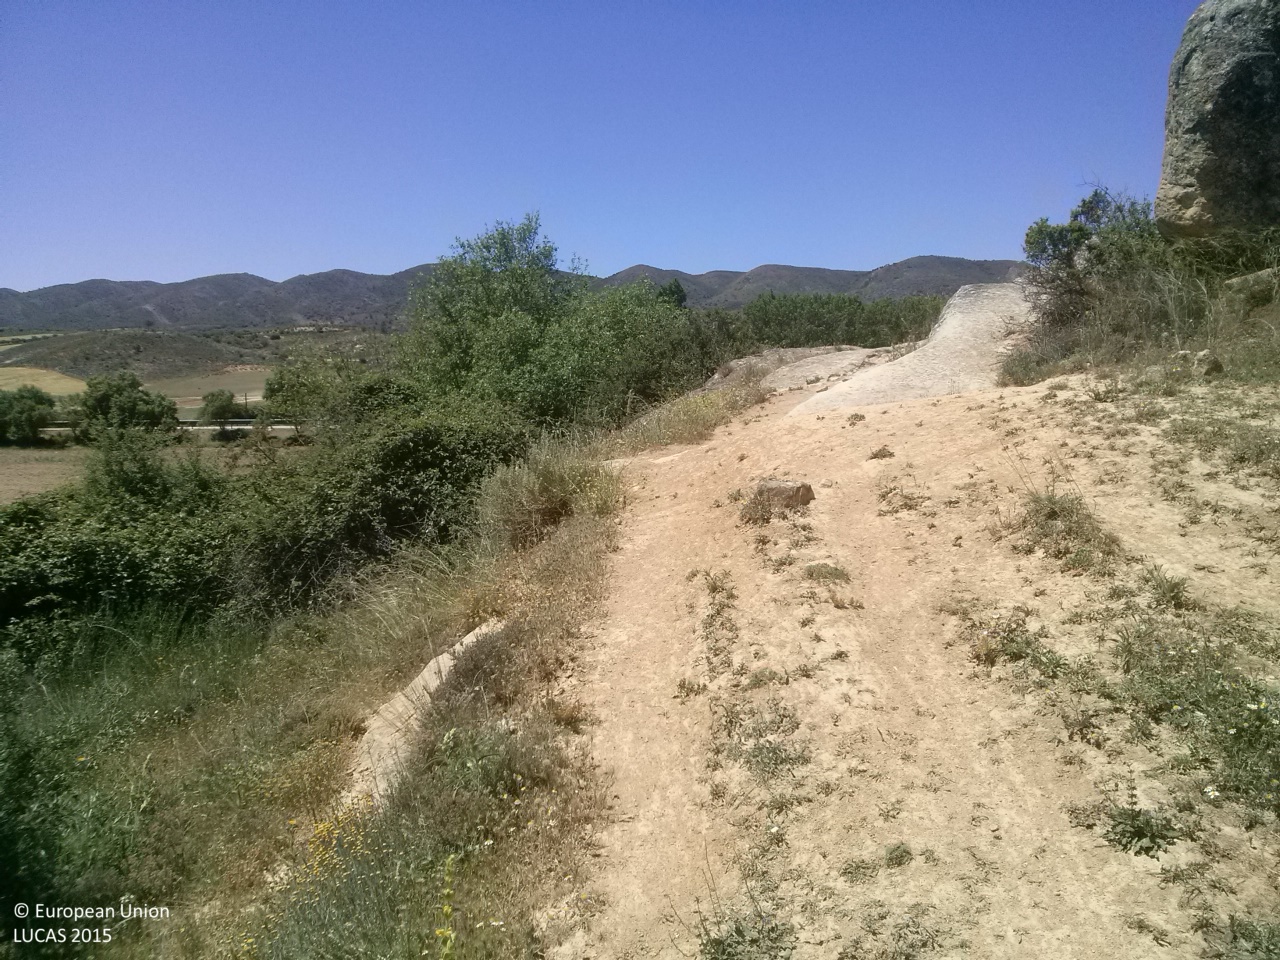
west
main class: Shrubland
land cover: Shrubland without tree cover
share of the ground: 25 - 50 %
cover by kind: shrubs 50 %, herbaceous plants 30 %, unconsolidated bare surface 20 %
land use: Semi-natural and natural areas not in use
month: May
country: ES
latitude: 40.2718
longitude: -2.7604
